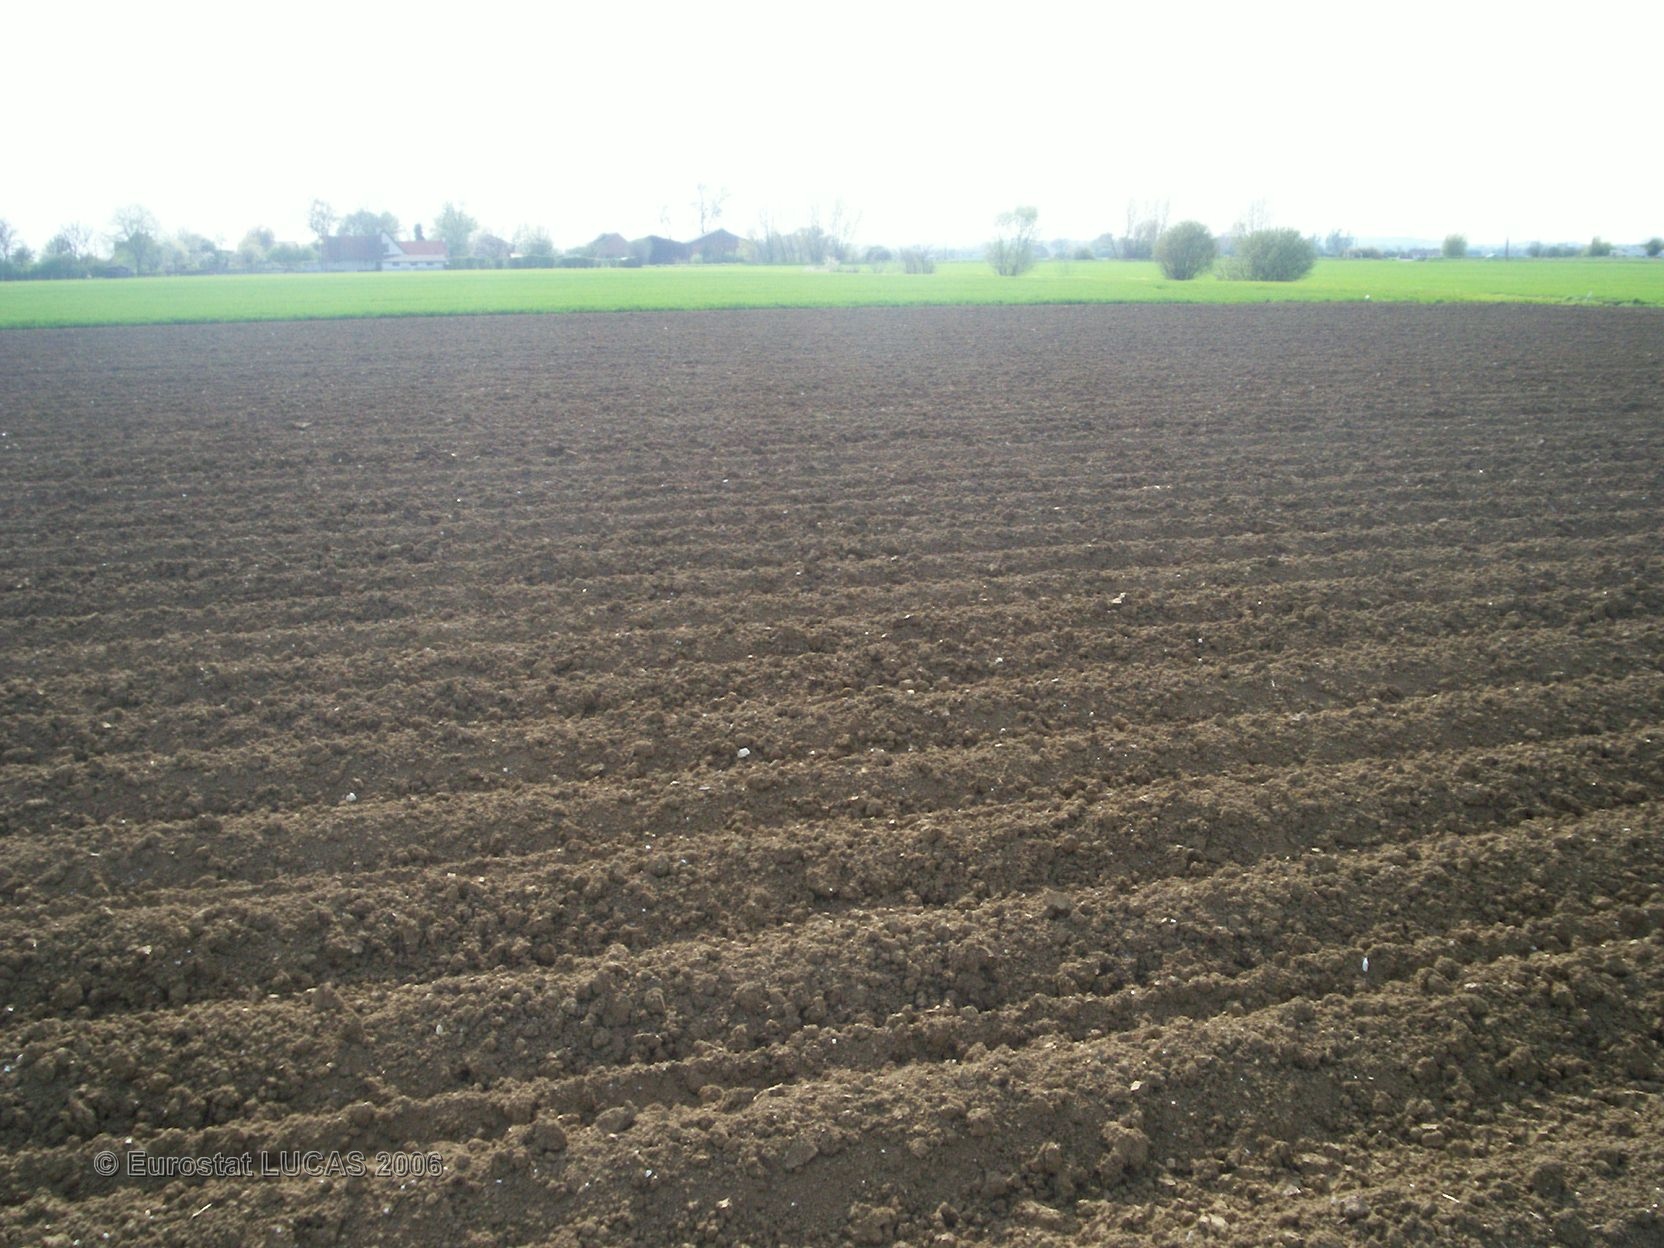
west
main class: Cropland
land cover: Potatoes
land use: Agriculture (excluding fallow land and kitchen gardens)
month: May
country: FR
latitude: 50.7009
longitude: 2.5828
